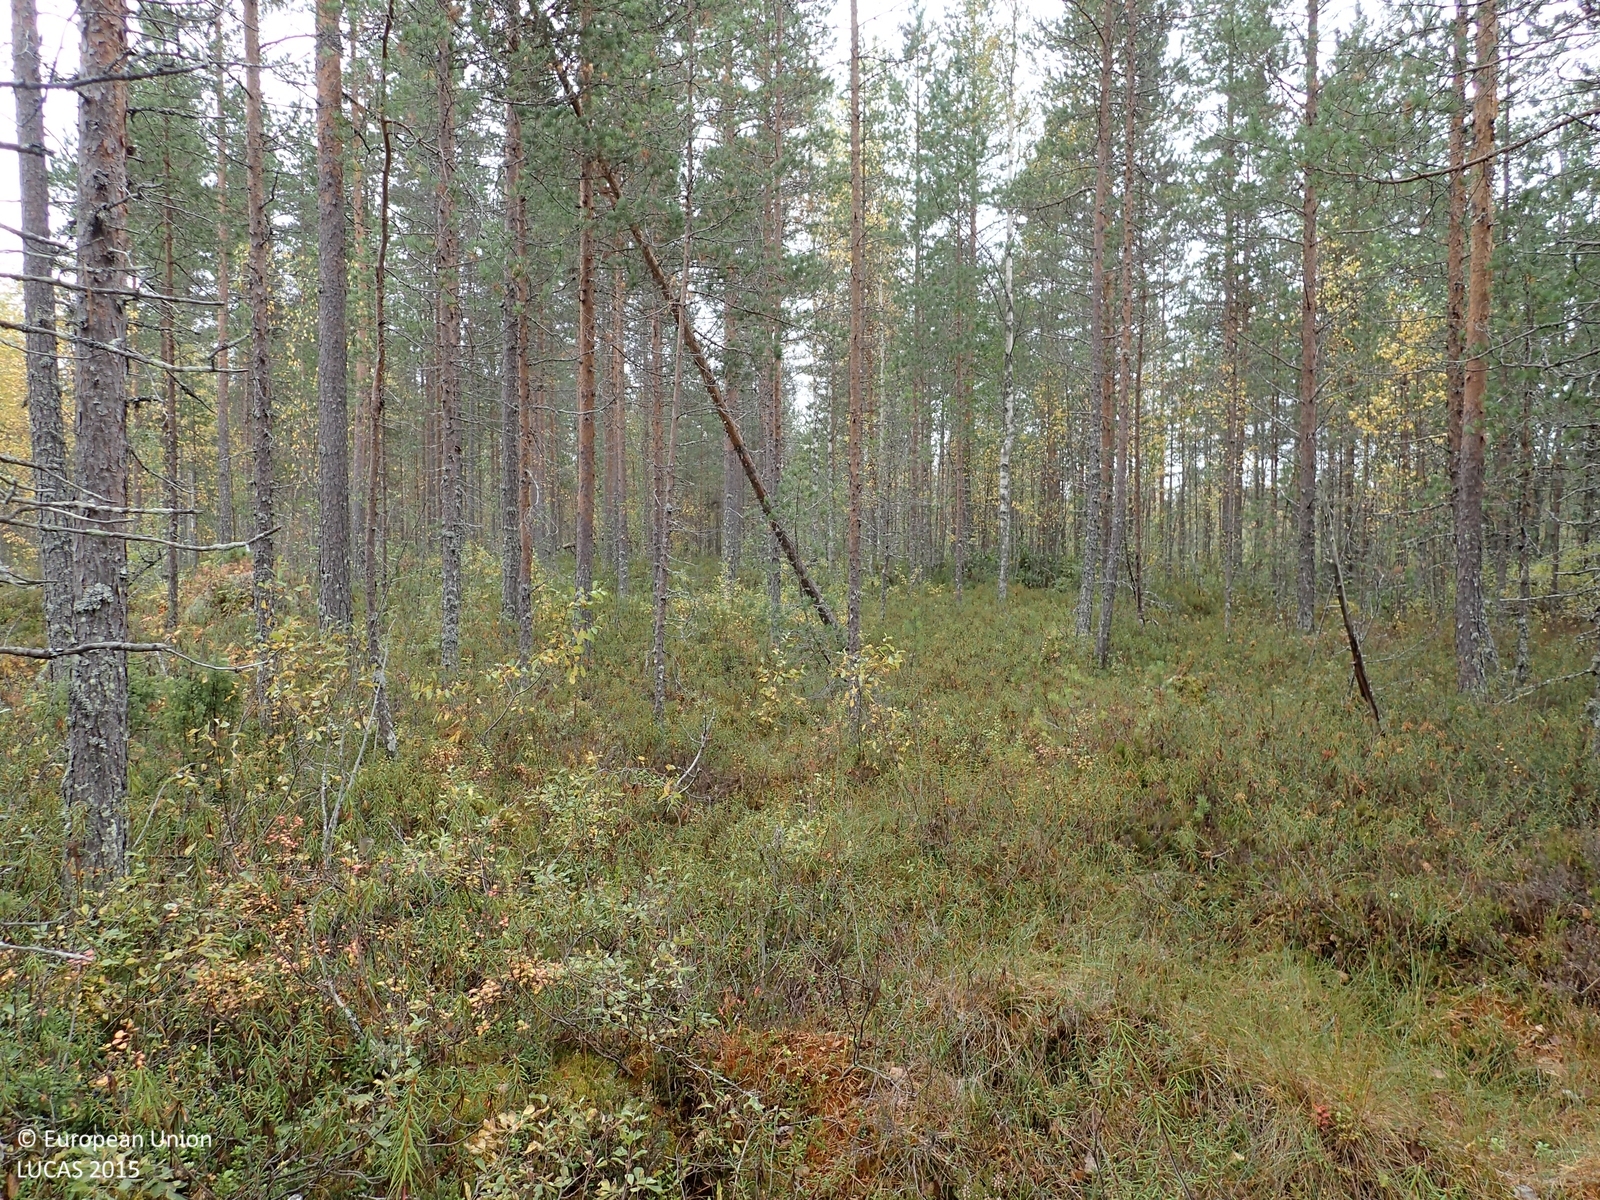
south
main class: Woodland
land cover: Pine dominated coniferous woodland
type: boreal forest
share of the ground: > 75 %
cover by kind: coniferous forest trees 70 %, shrubs 25 %, broadleaved forest trees 5 %
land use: Forestry
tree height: < 5 m
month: September
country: FI
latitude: 63.4586
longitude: 24.9942
